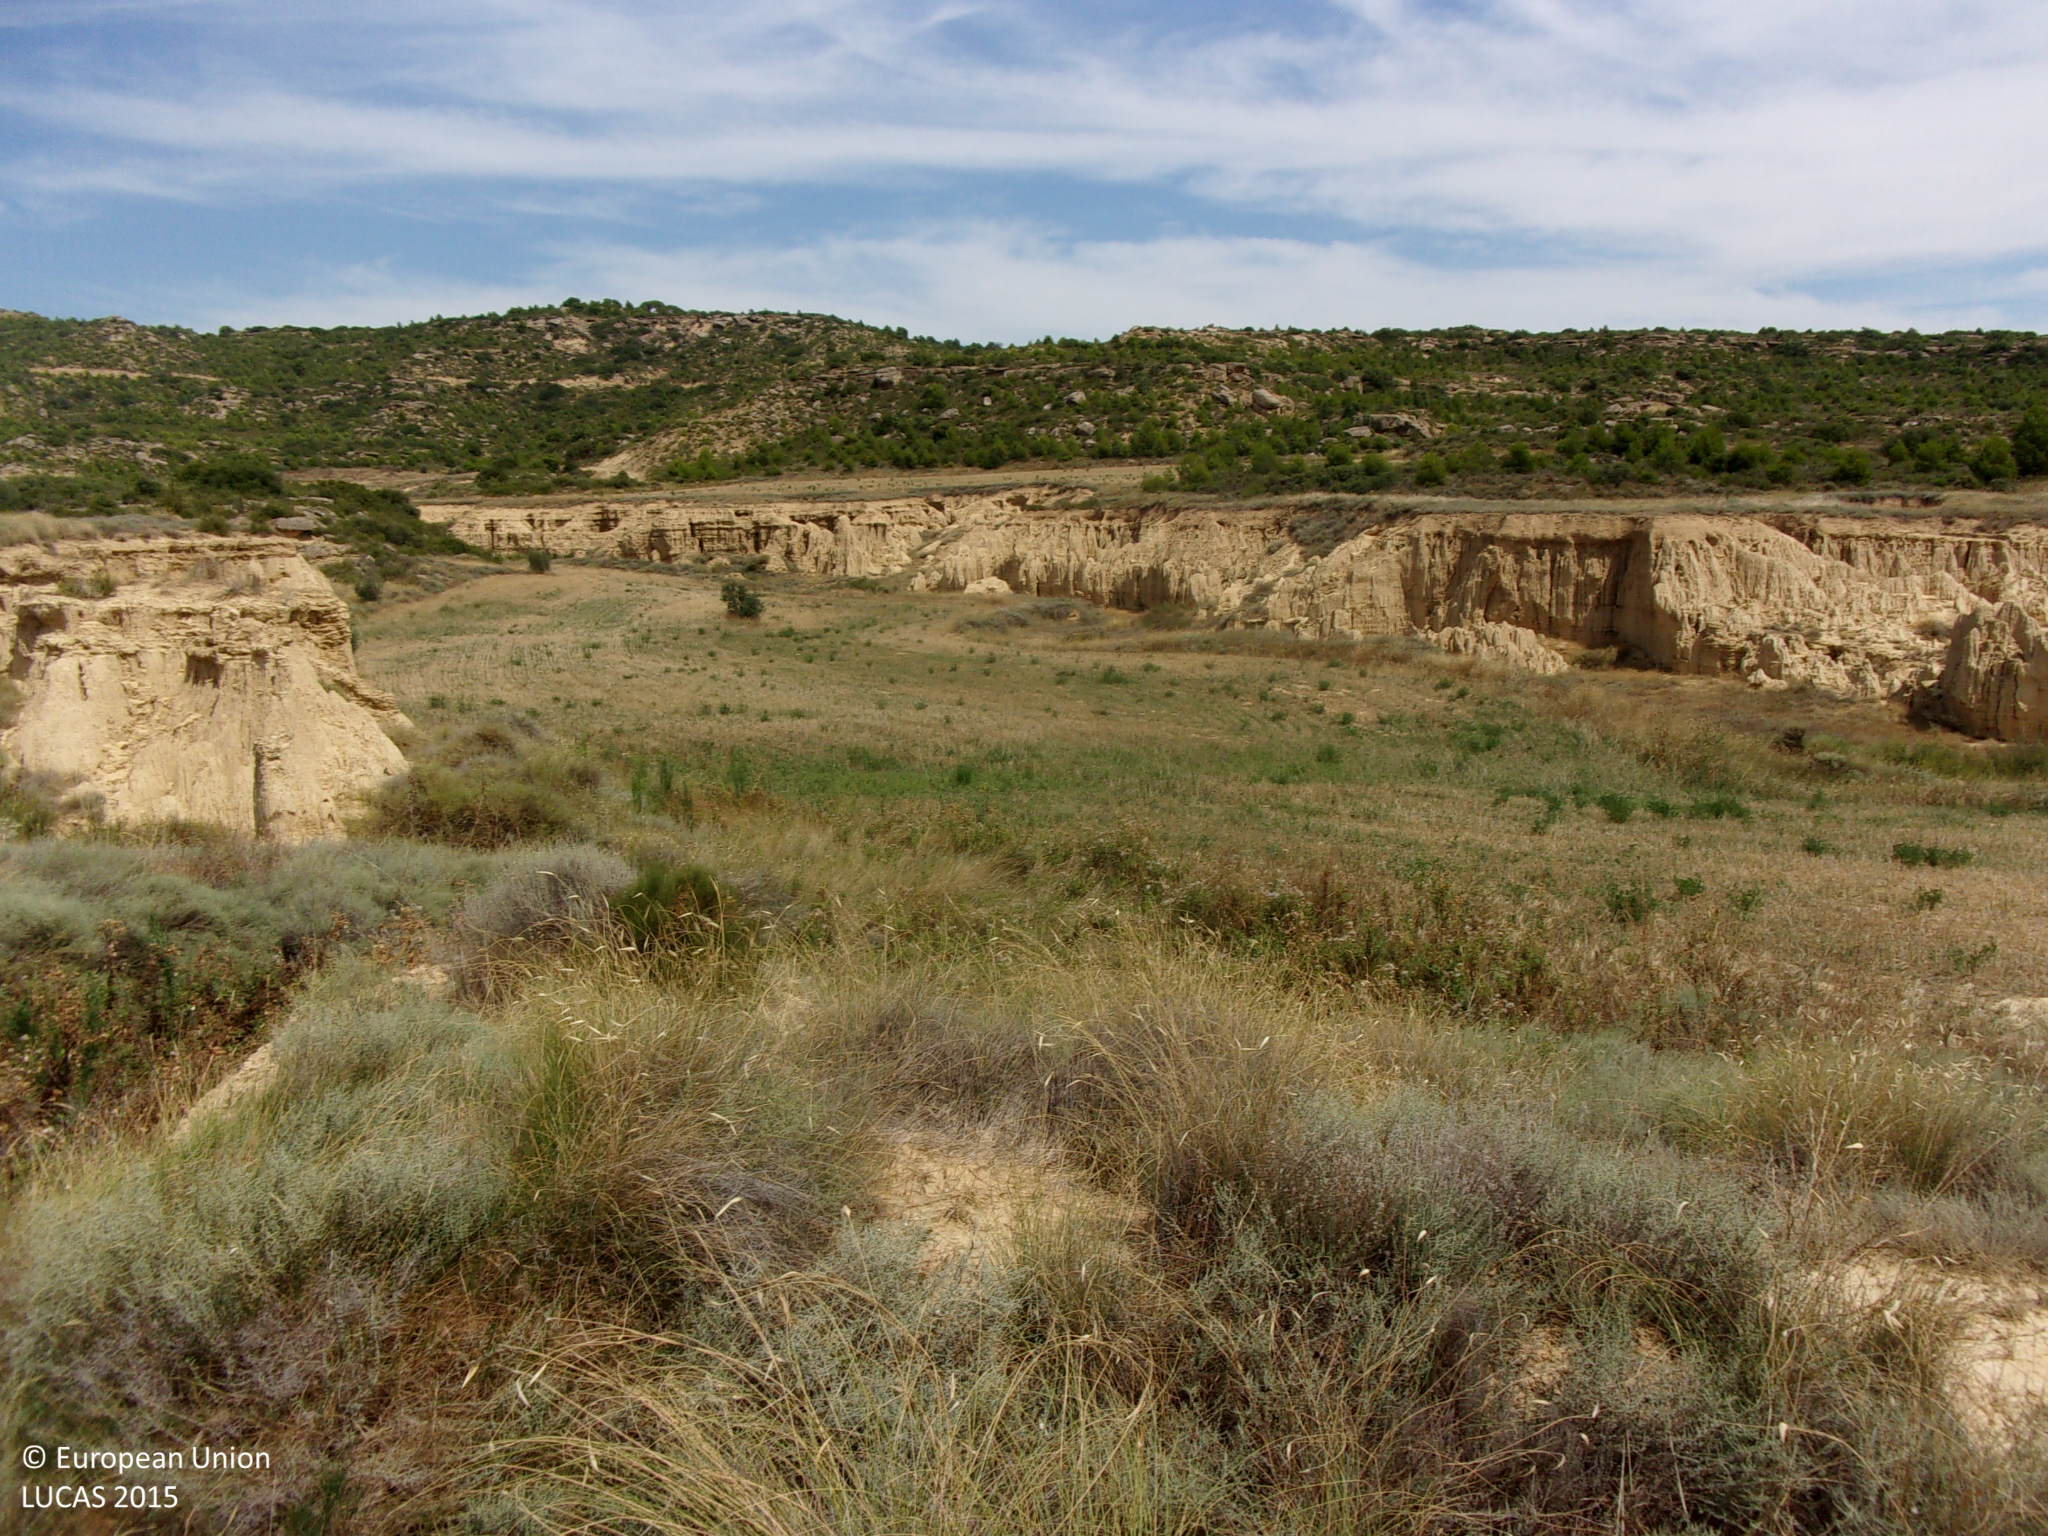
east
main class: Shrubland
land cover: Shrubland without tree cover
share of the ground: > 75 %
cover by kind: shrubs 65 %, herbaceous plants 25 %, consolidated bare surface 10 %
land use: Semi-natural and natural areas not in use
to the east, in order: Shrubland without tree cover; Barley; Shrubland without tree cover; Barley; Shrubland without tree cover; Pine dominated coniferous woodland; Rock outcrops; Shrubland without tree cover
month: August
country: ES
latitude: 42.1743
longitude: -1.0564
